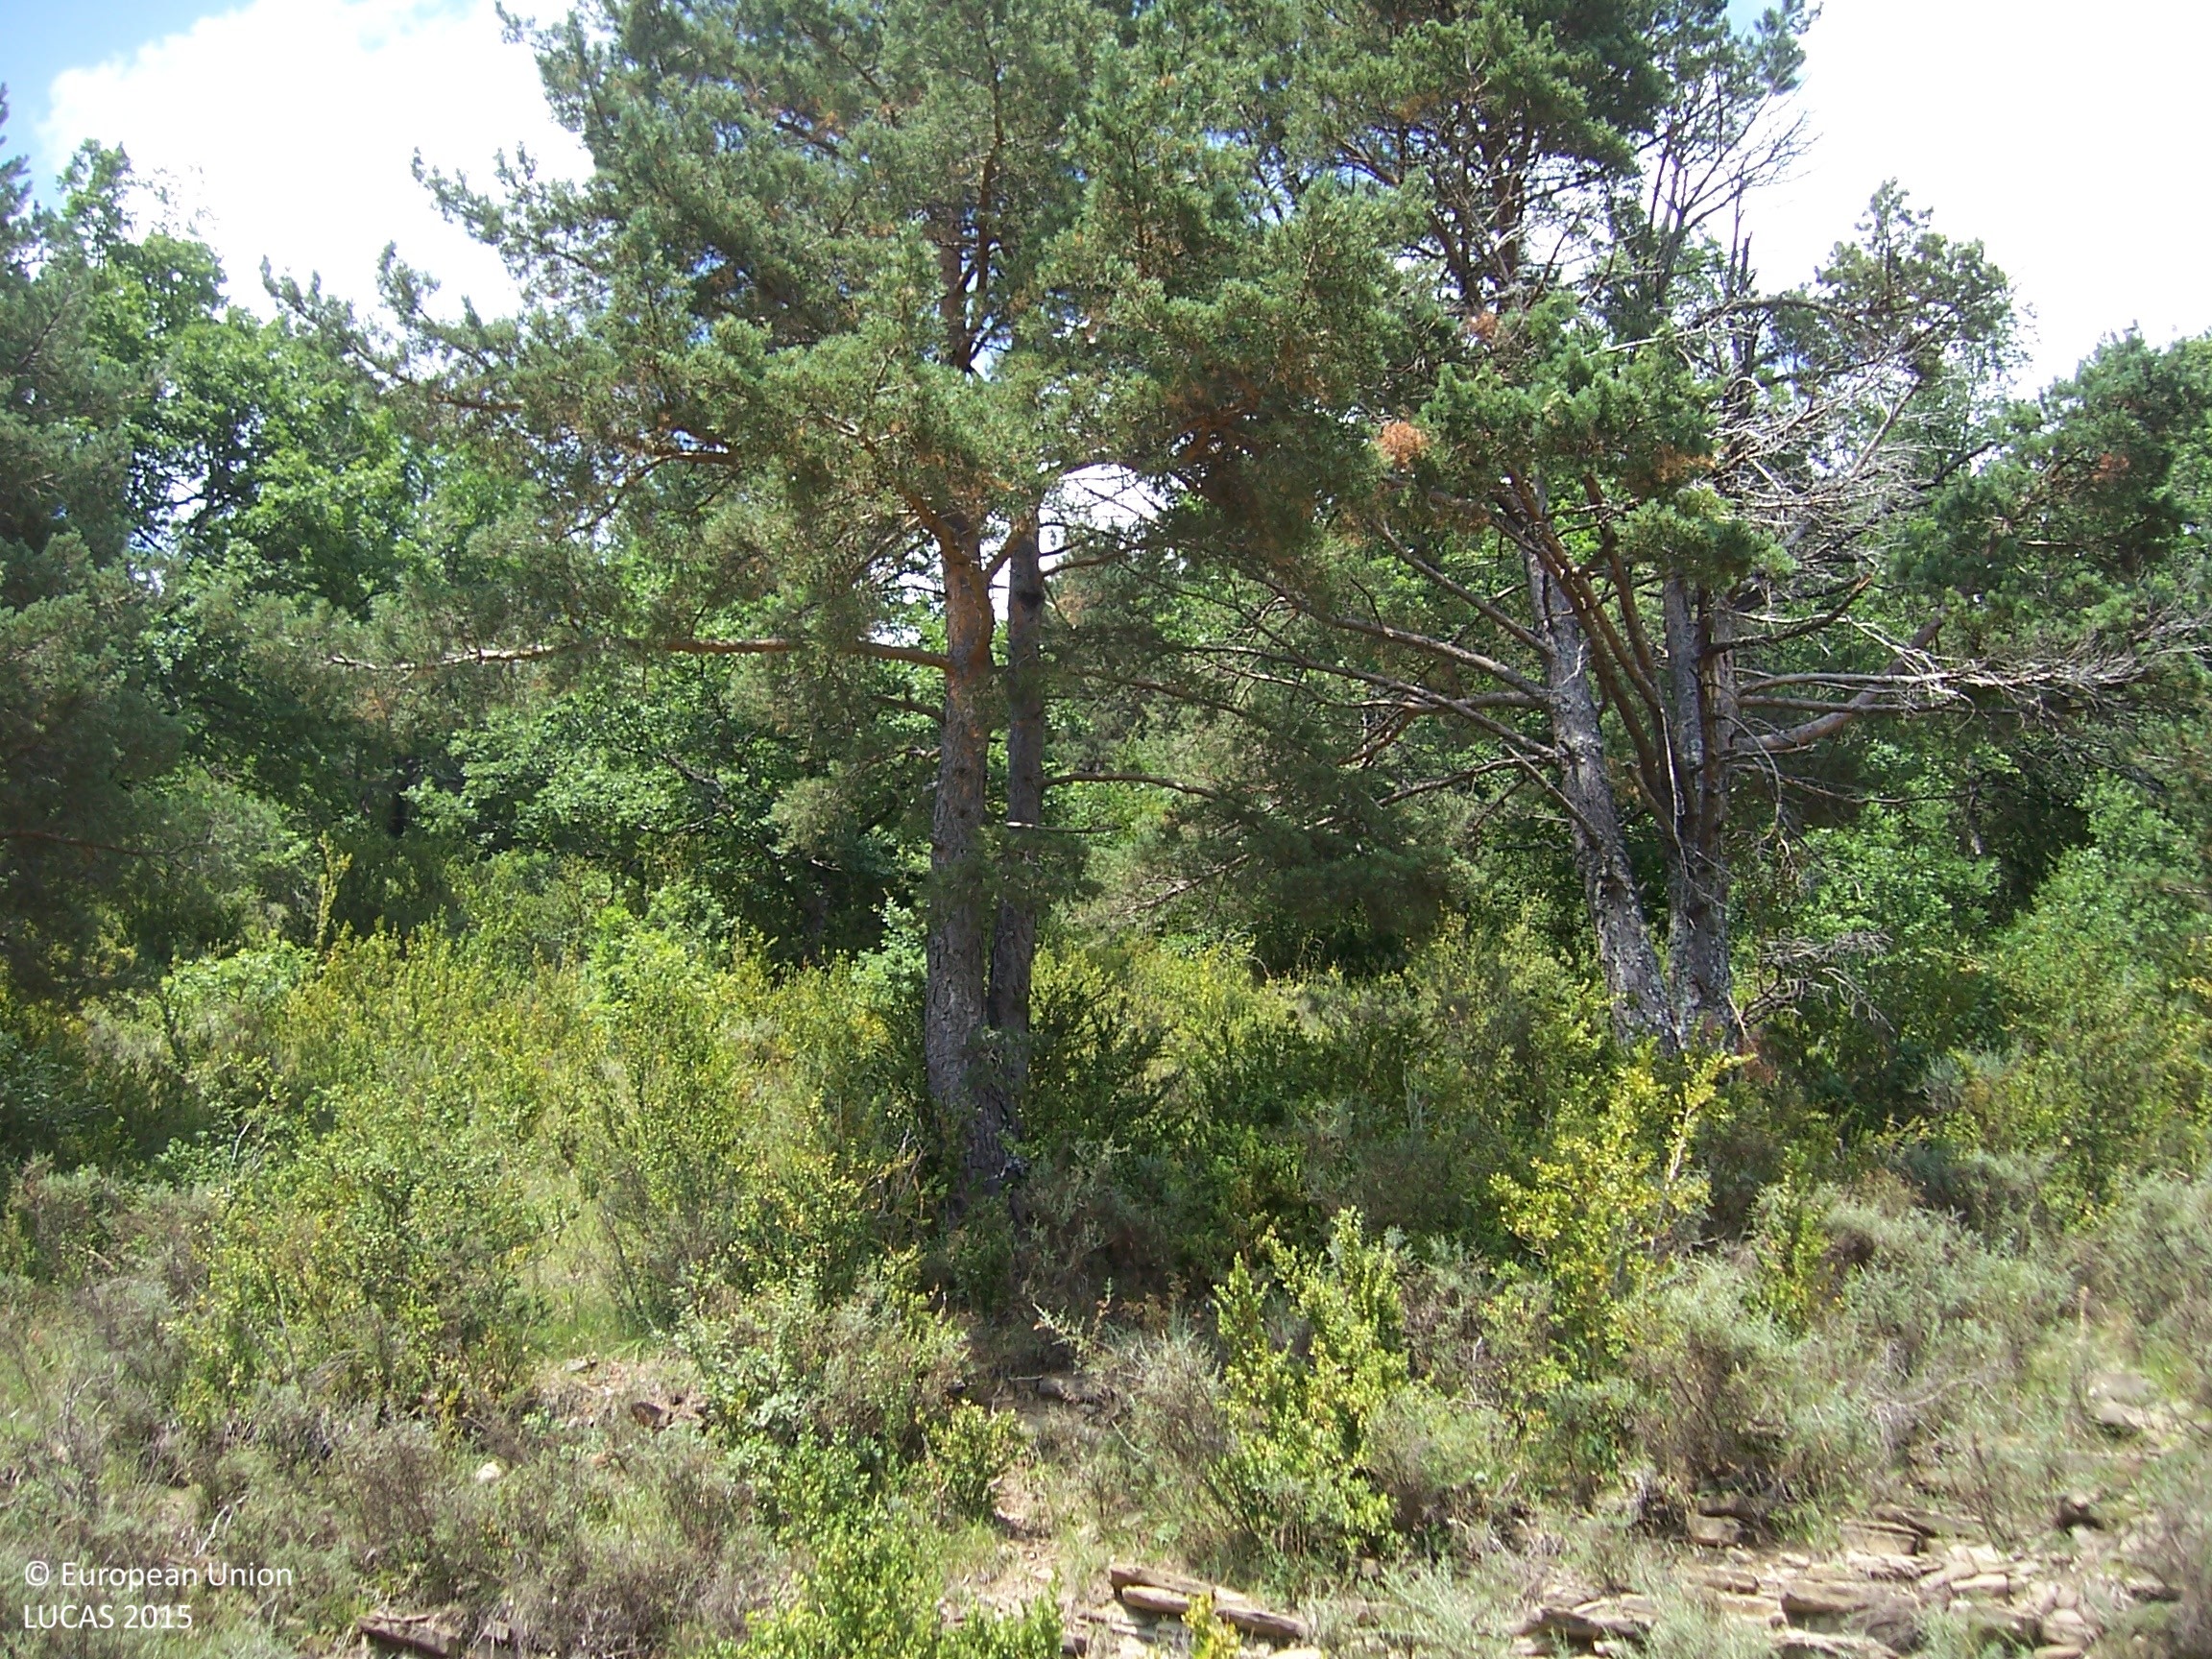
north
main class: Woodland
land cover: Pine dominated coniferous woodland
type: alpine coniferous forest
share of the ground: > 75 %
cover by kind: coniferous forest trees 85 %, shrubs 10 %, unconsolidated bare surface 5 %
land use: Forestry
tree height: > 5 m
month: August
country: ES
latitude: 42.6467
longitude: -0.3818
